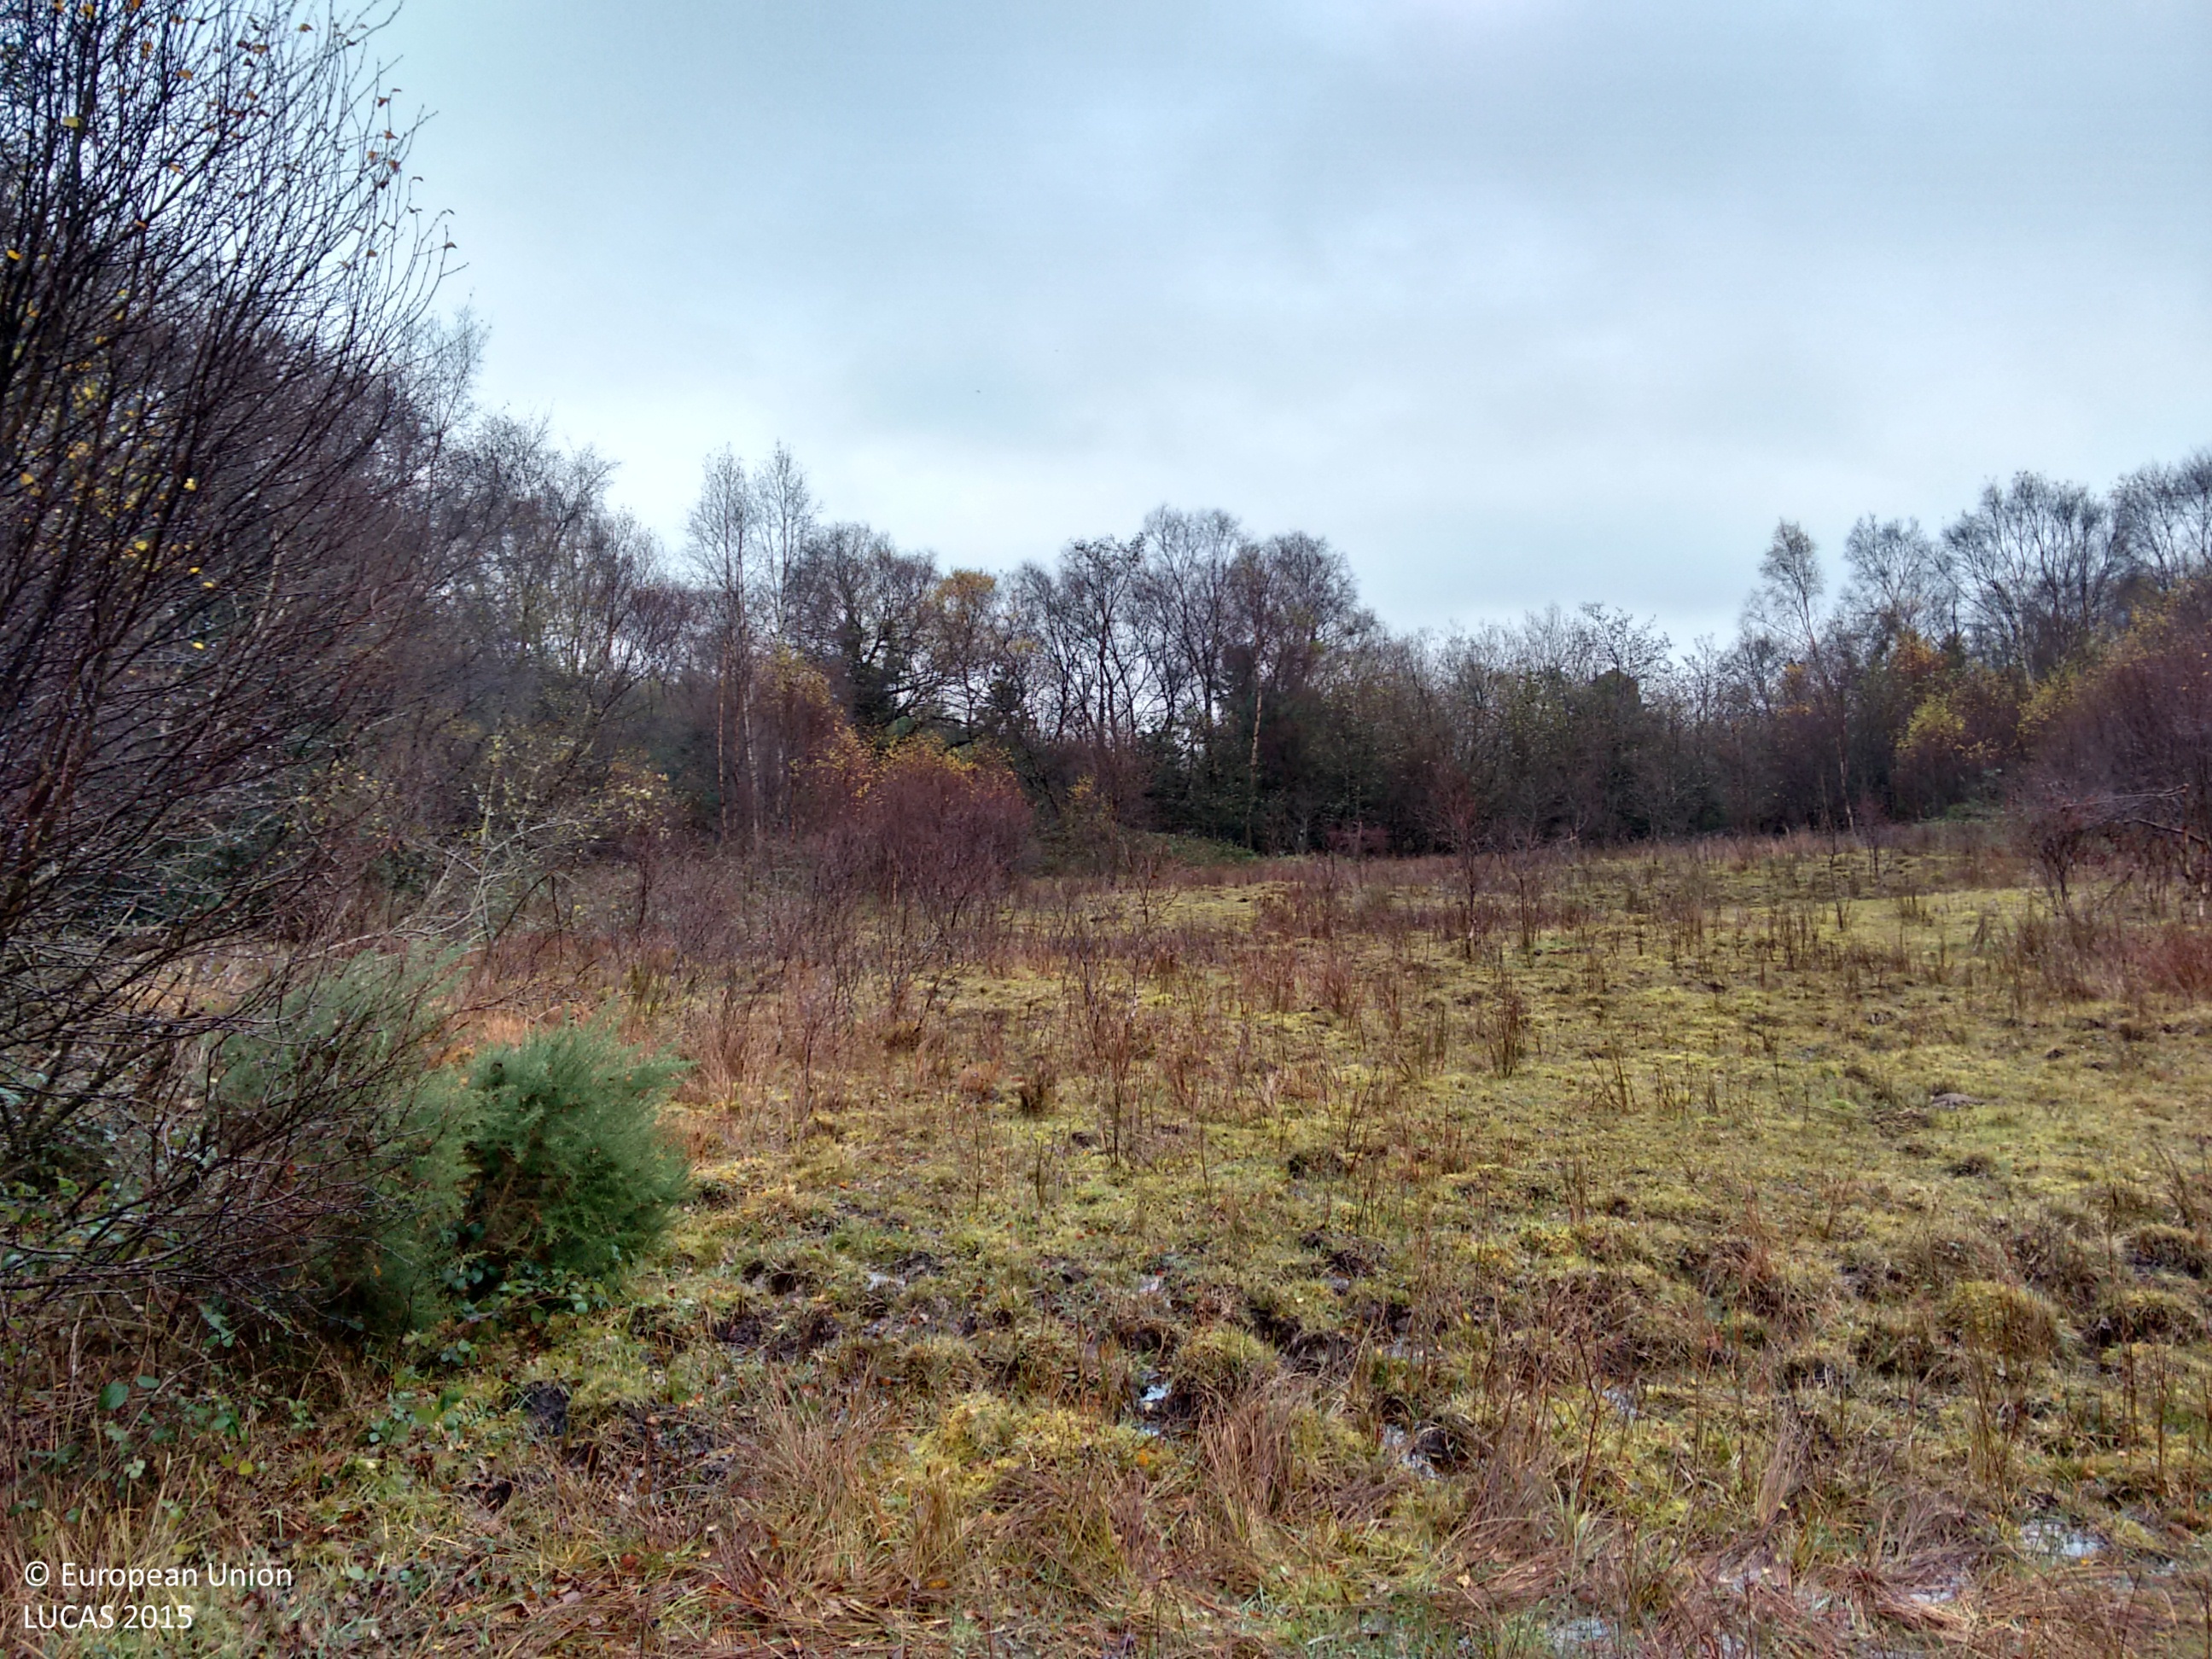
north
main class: Woodland
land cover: Broadleaved woodland
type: mesophytic deciduous forest
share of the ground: > 75 %
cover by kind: broadleaved forest trees 60 %, herbaceous plants 40 %
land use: Agriculture (excluding fallow land and kitchen gardens)
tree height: > 5 m
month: November
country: IE
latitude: 54.3436
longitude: -8.0020
